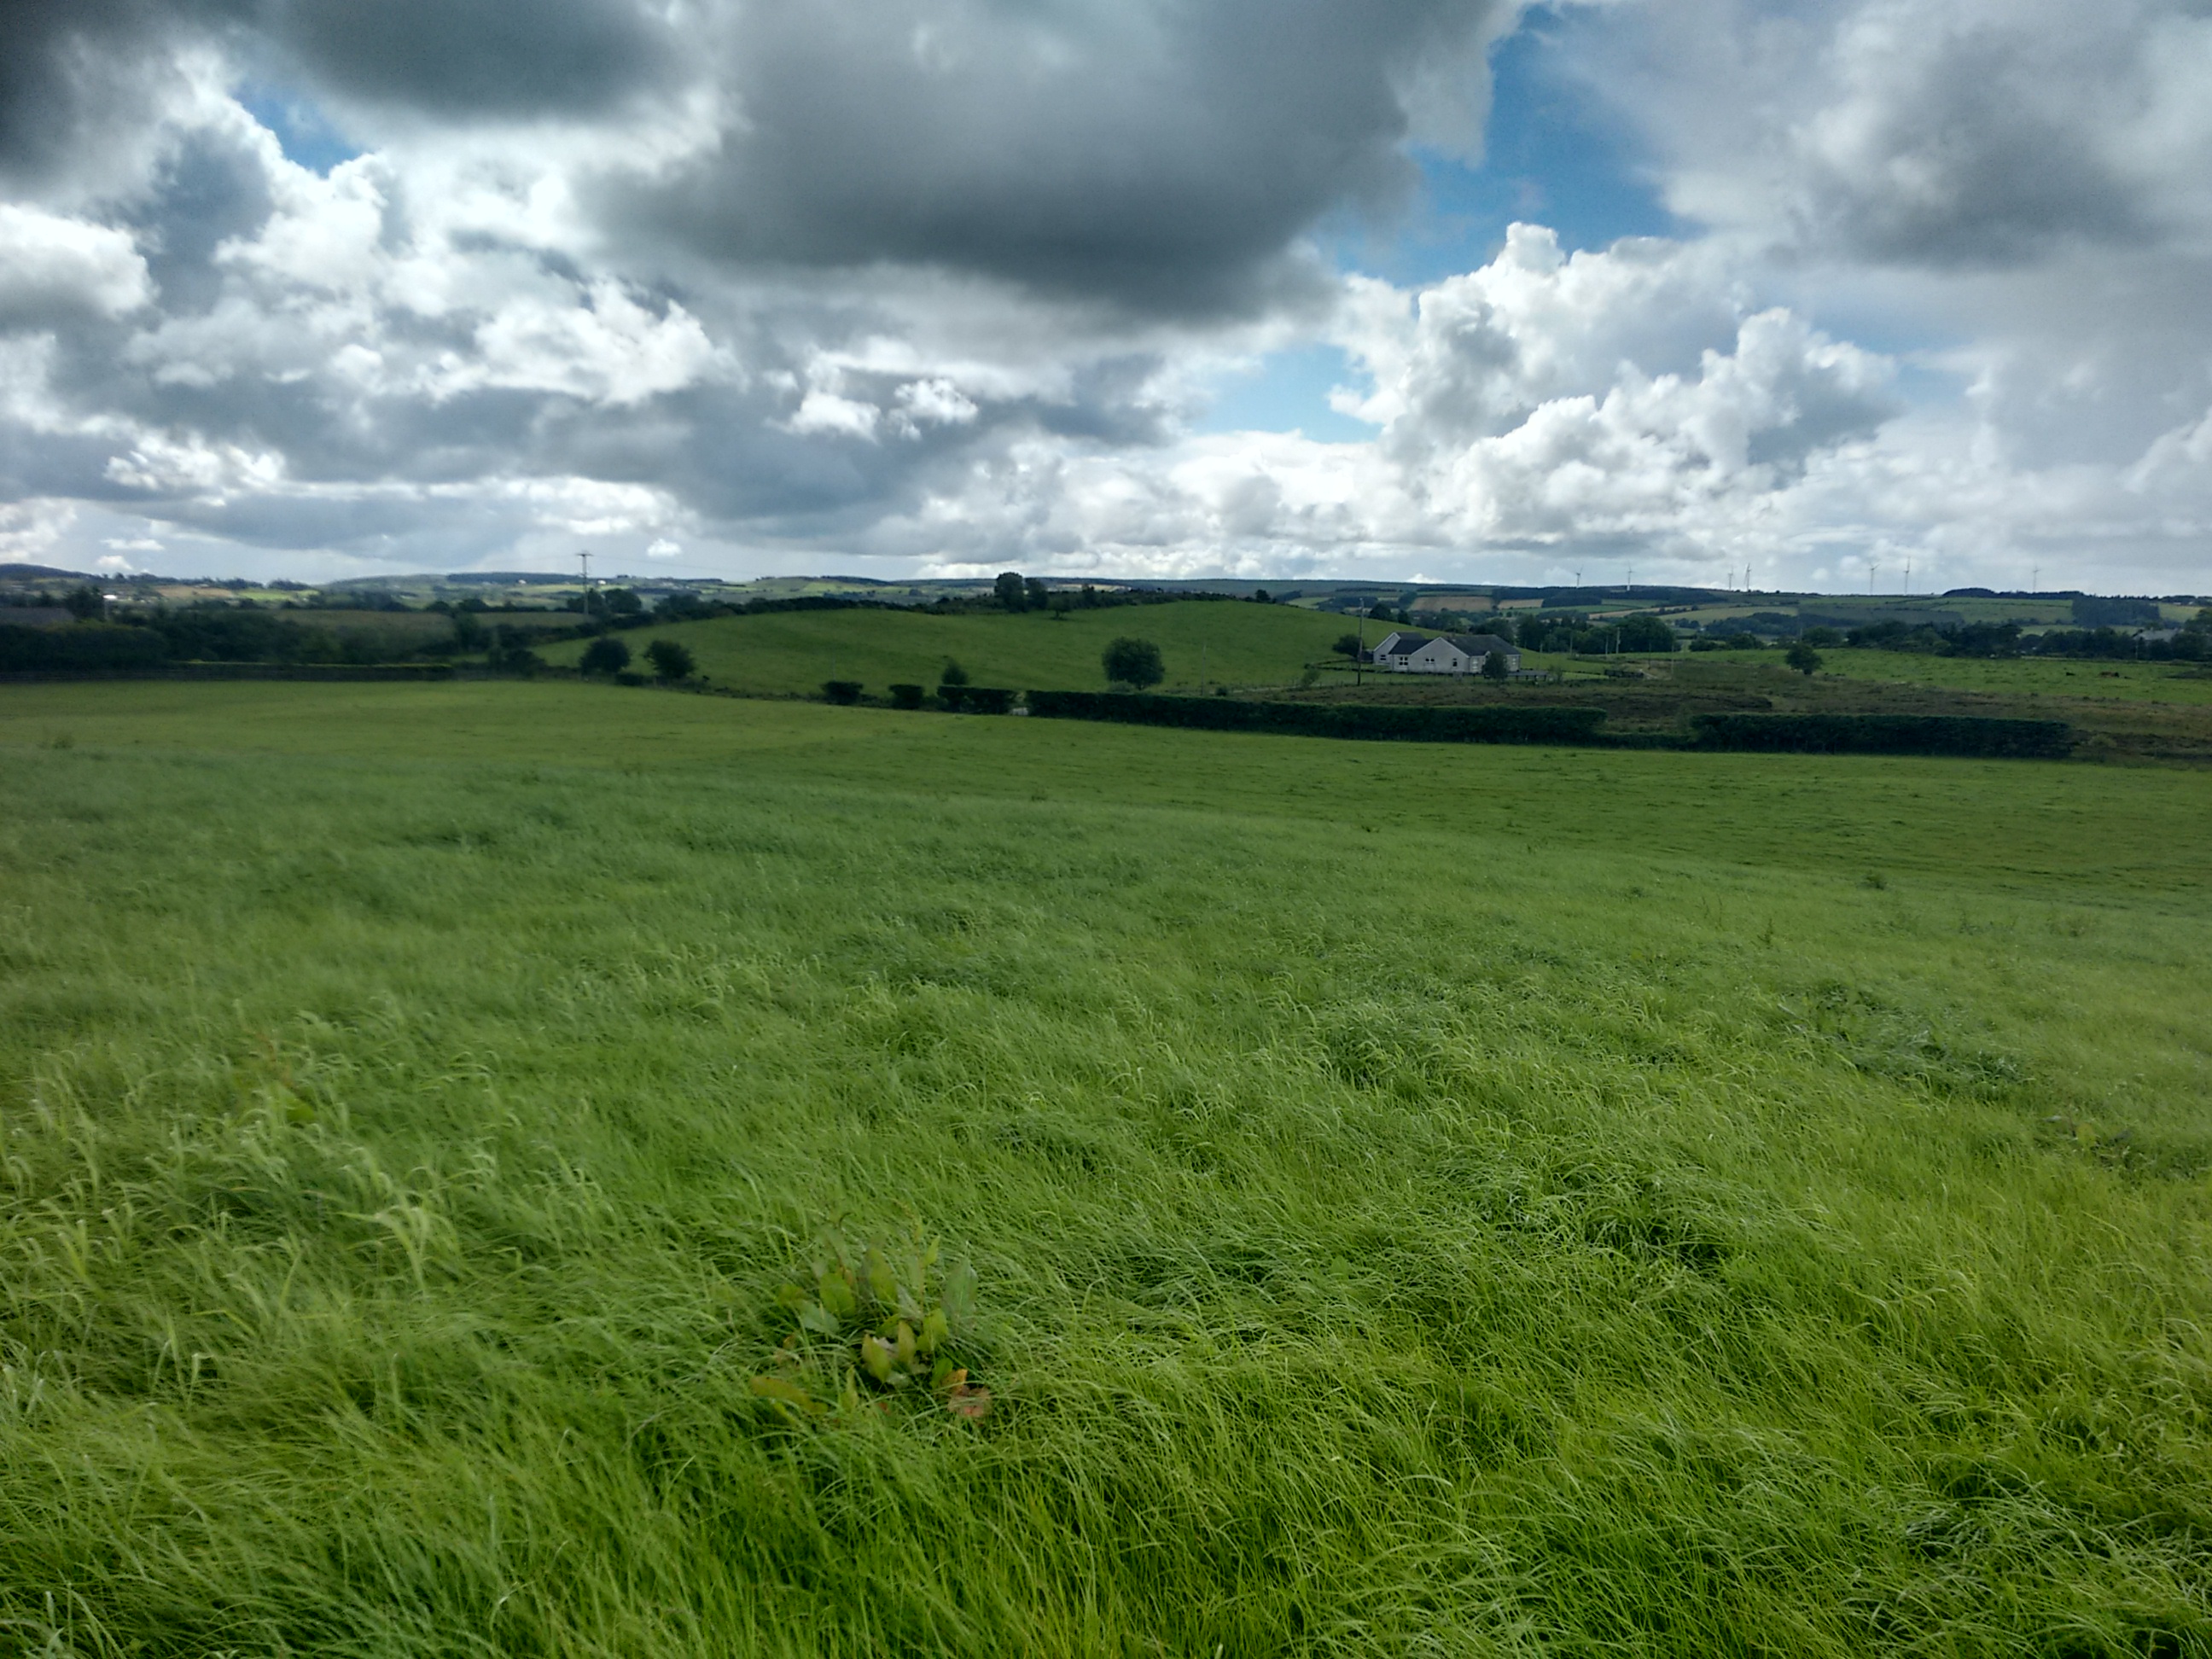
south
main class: Grassland
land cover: Grassland without tree/shrub cover
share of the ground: > 75 %
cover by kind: herbaceous plants 100 %
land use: Agriculture (excluding fallow land and kitchen gardens)
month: July
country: GB
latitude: 54.5989
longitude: -6.9956
